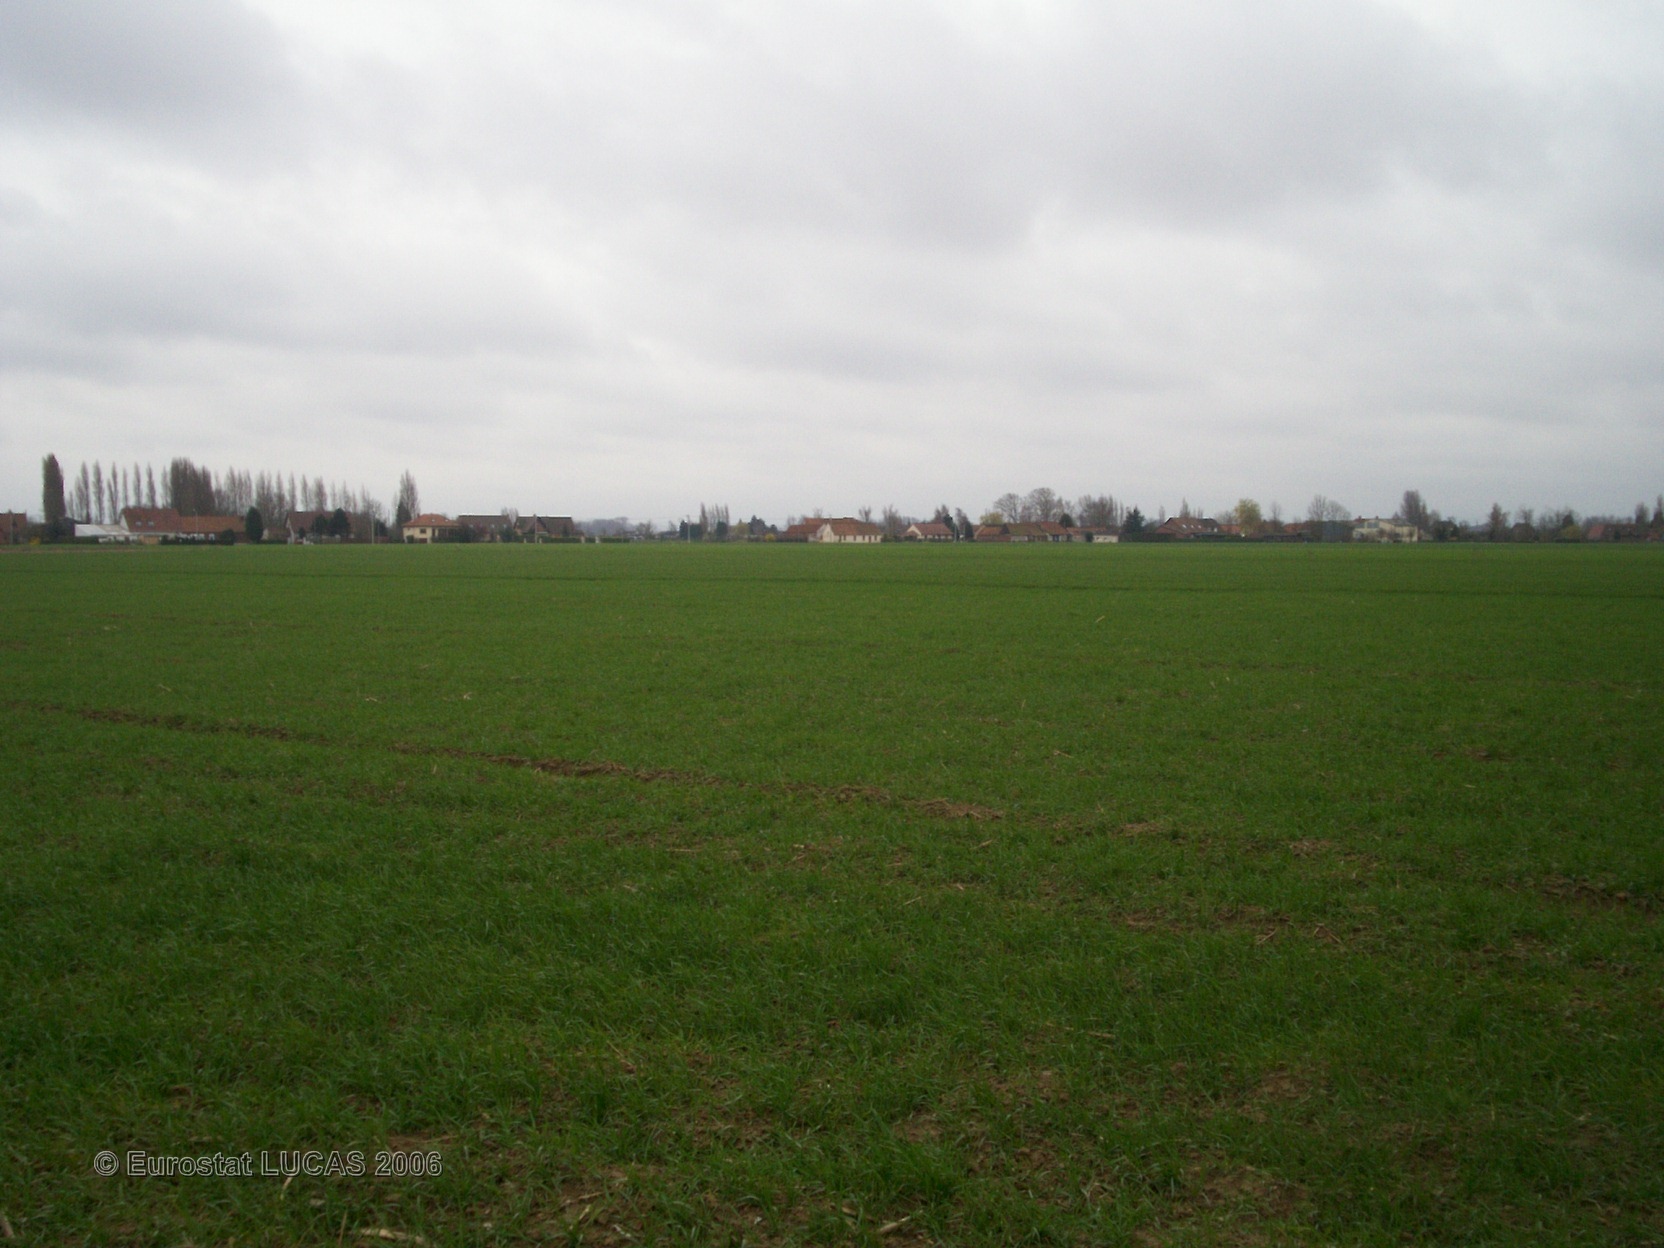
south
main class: Cropland
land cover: Common wheat
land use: Agriculture (excluding fallow land and kitchen gardens)
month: April
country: FR
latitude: 50.6061
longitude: 2.5126
